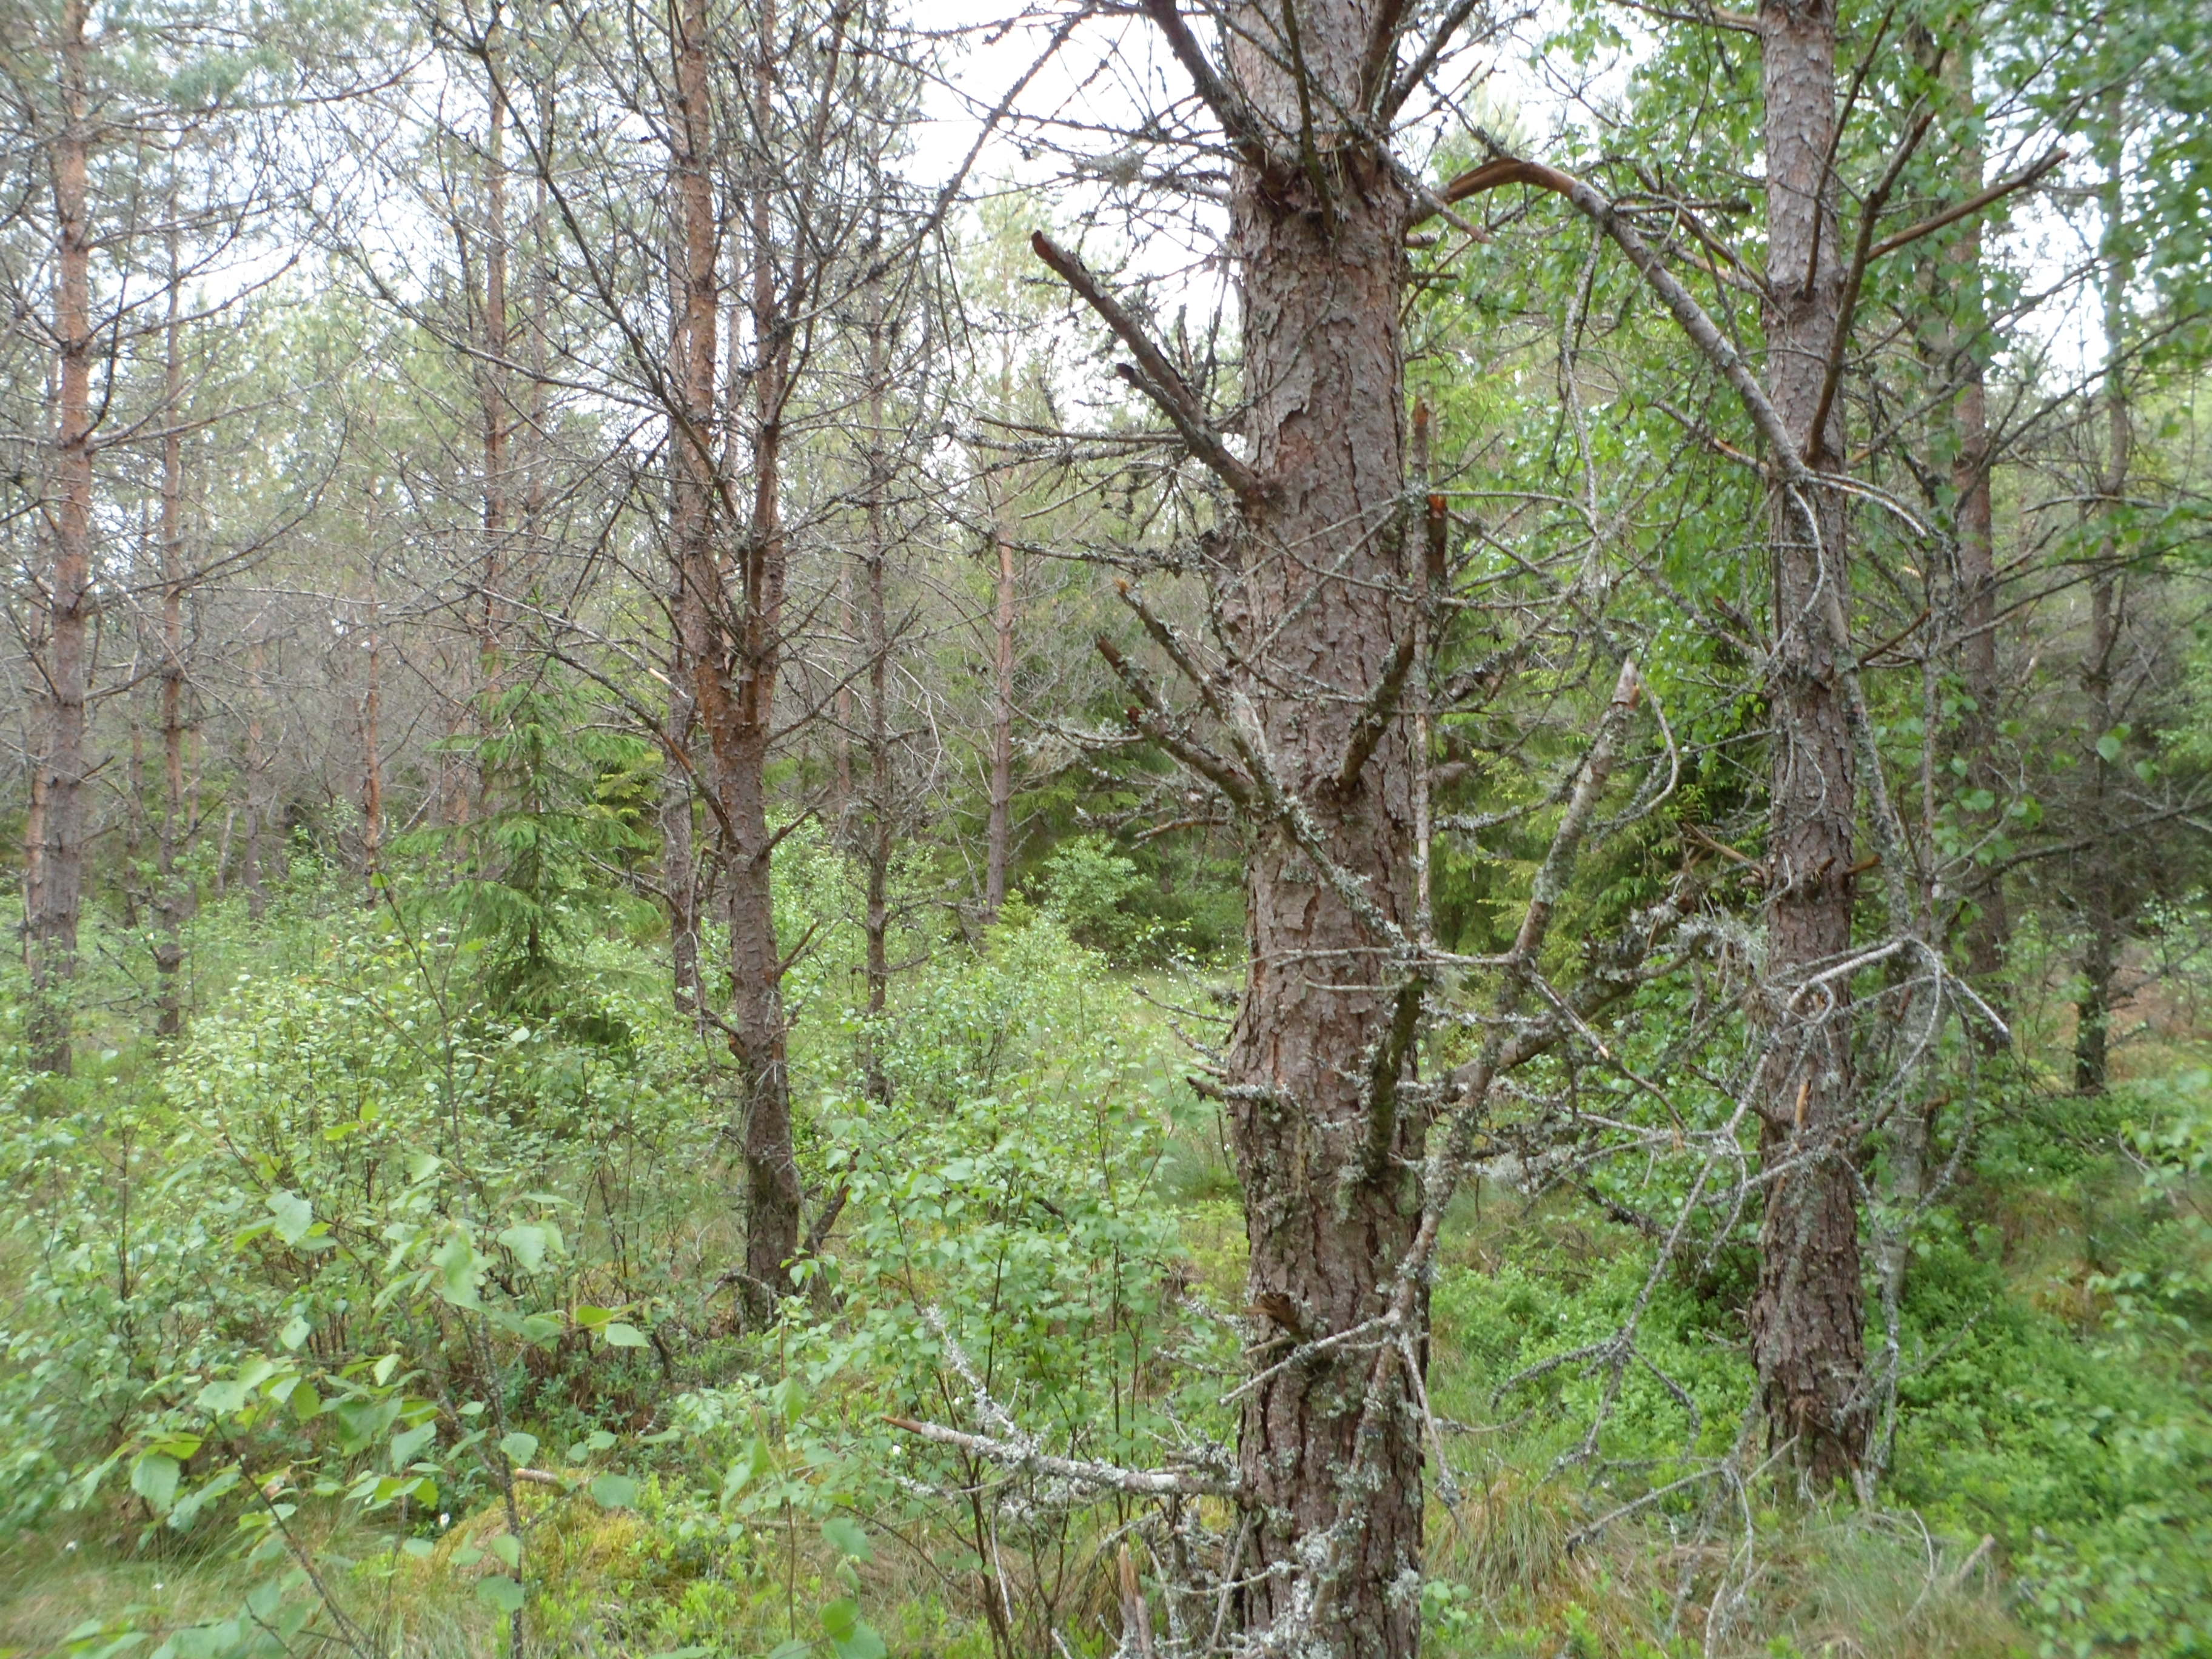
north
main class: Woodland
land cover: Pine dominated coniferous woodland
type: boreal forest
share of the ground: 50 - 75 %
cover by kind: coniferous forest trees 55 %, herbaceous plants 20 %, broadleaved forest trees 10 %, shrubs 10 %, lichens and mosses 5 %
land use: Forestry
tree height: > 5 m
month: June
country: SE
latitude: 56.9738
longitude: 14.4878
